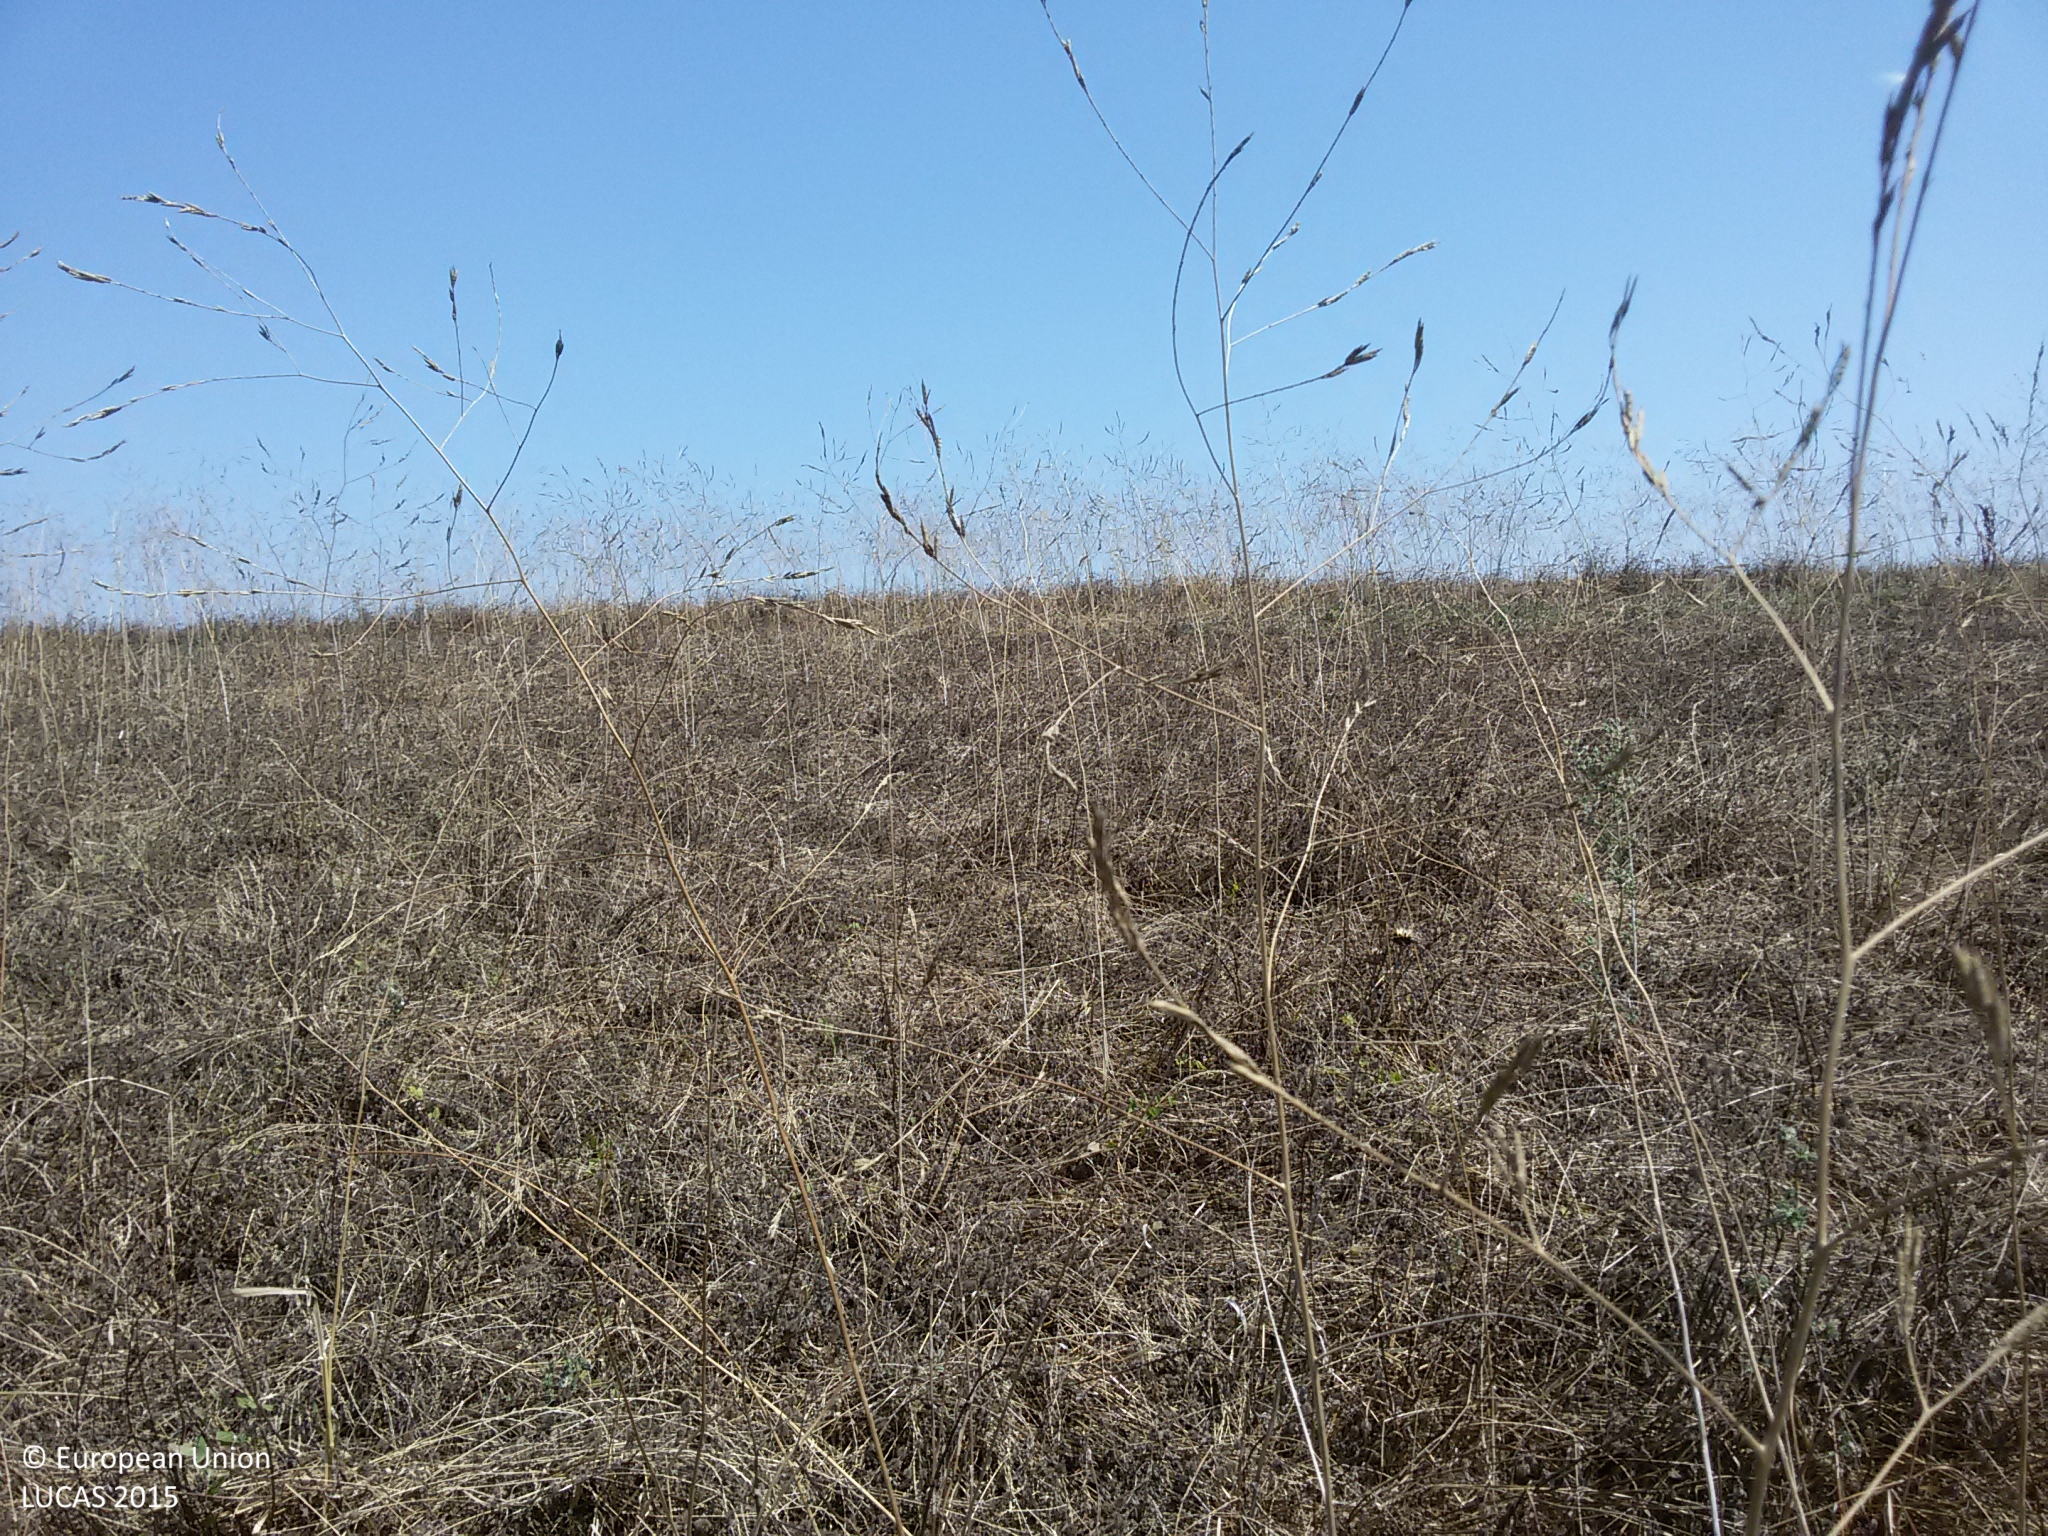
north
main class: Grassland
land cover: Grassland without tree/shrub cover
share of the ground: > 75 %
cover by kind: herbaceous plants 95 %, unconsolidated bare surface 5 %
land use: Agriculture (excluding fallow land and kitchen gardens)
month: July
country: IT
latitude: 42.4429
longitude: 11.5871
